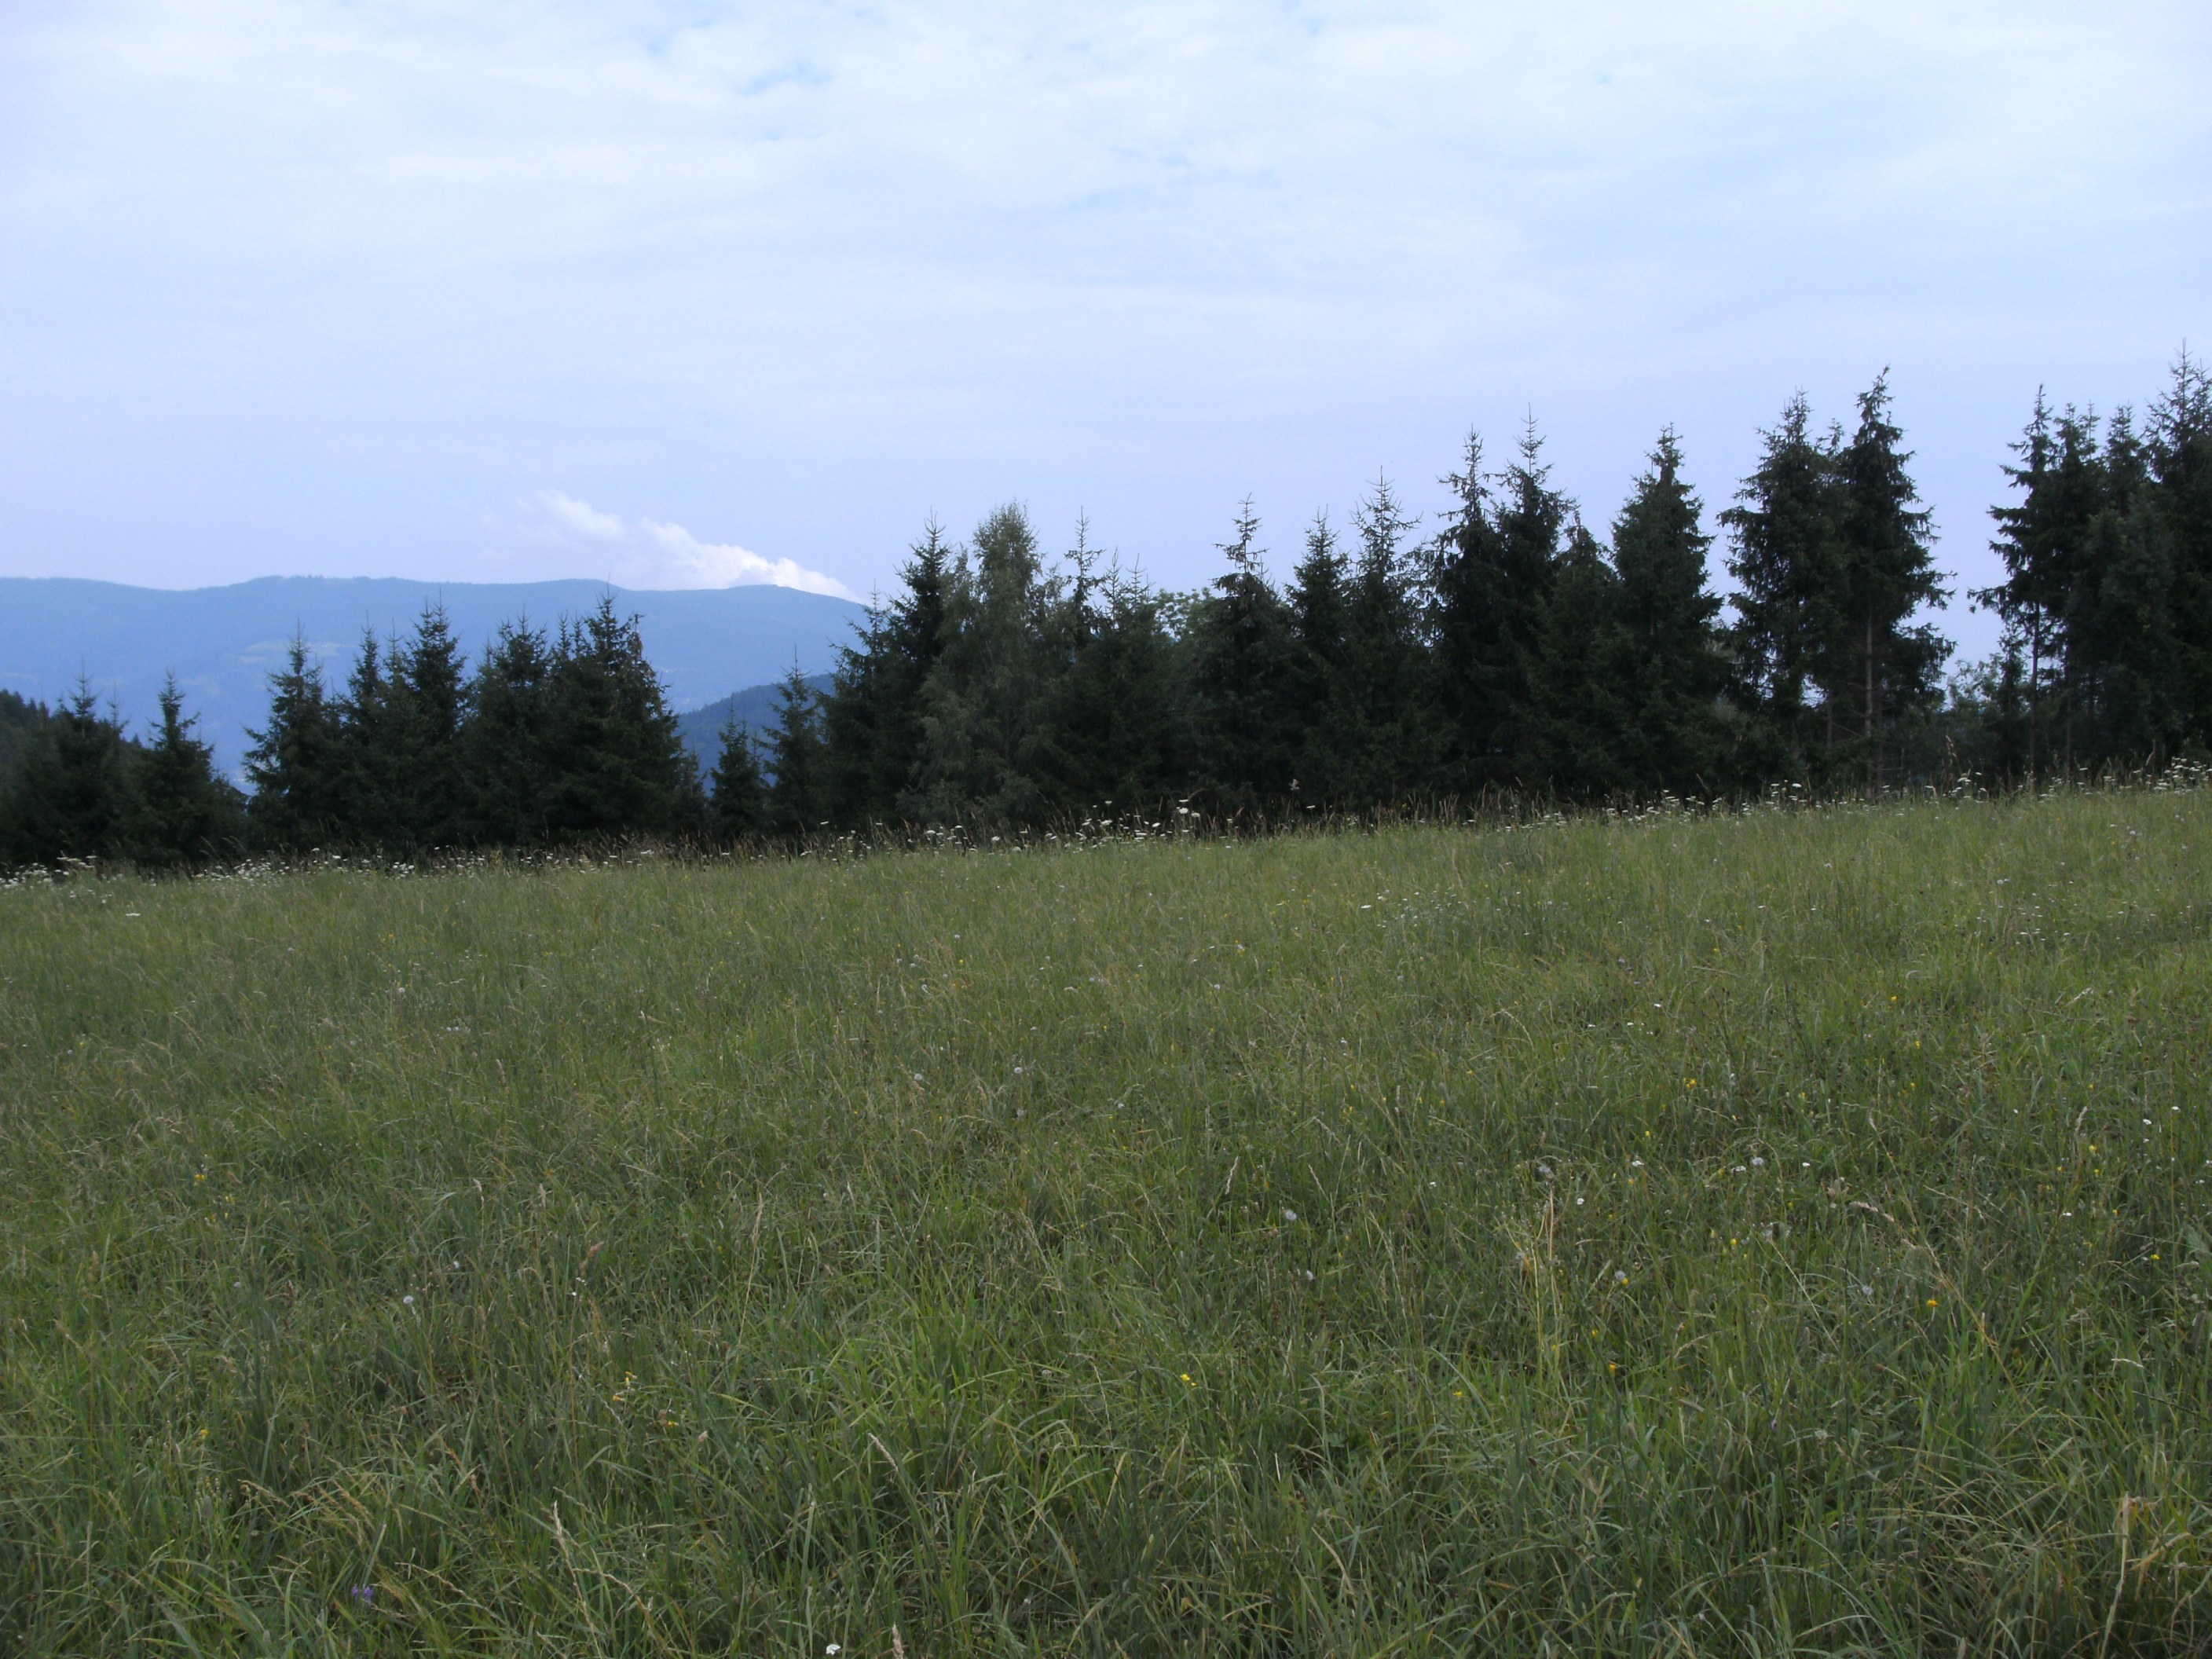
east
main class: Grassland
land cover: Grassland without tree/shrub cover
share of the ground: > 75 %
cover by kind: herbaceous plants 100 %
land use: Agriculture (excluding fallow land and kitchen gardens)
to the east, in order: Grassland without tree/shrub cover; Tracks; Grassland without tree/shrub cover; Spruce dominated coniferous woodland; Tracks; Broadleaved woodland; Spruce dominated mixed woodland; Rivers and streams; Spruce dominated mixed woodland
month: July
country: AT
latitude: 46.6372
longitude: 14.8706
